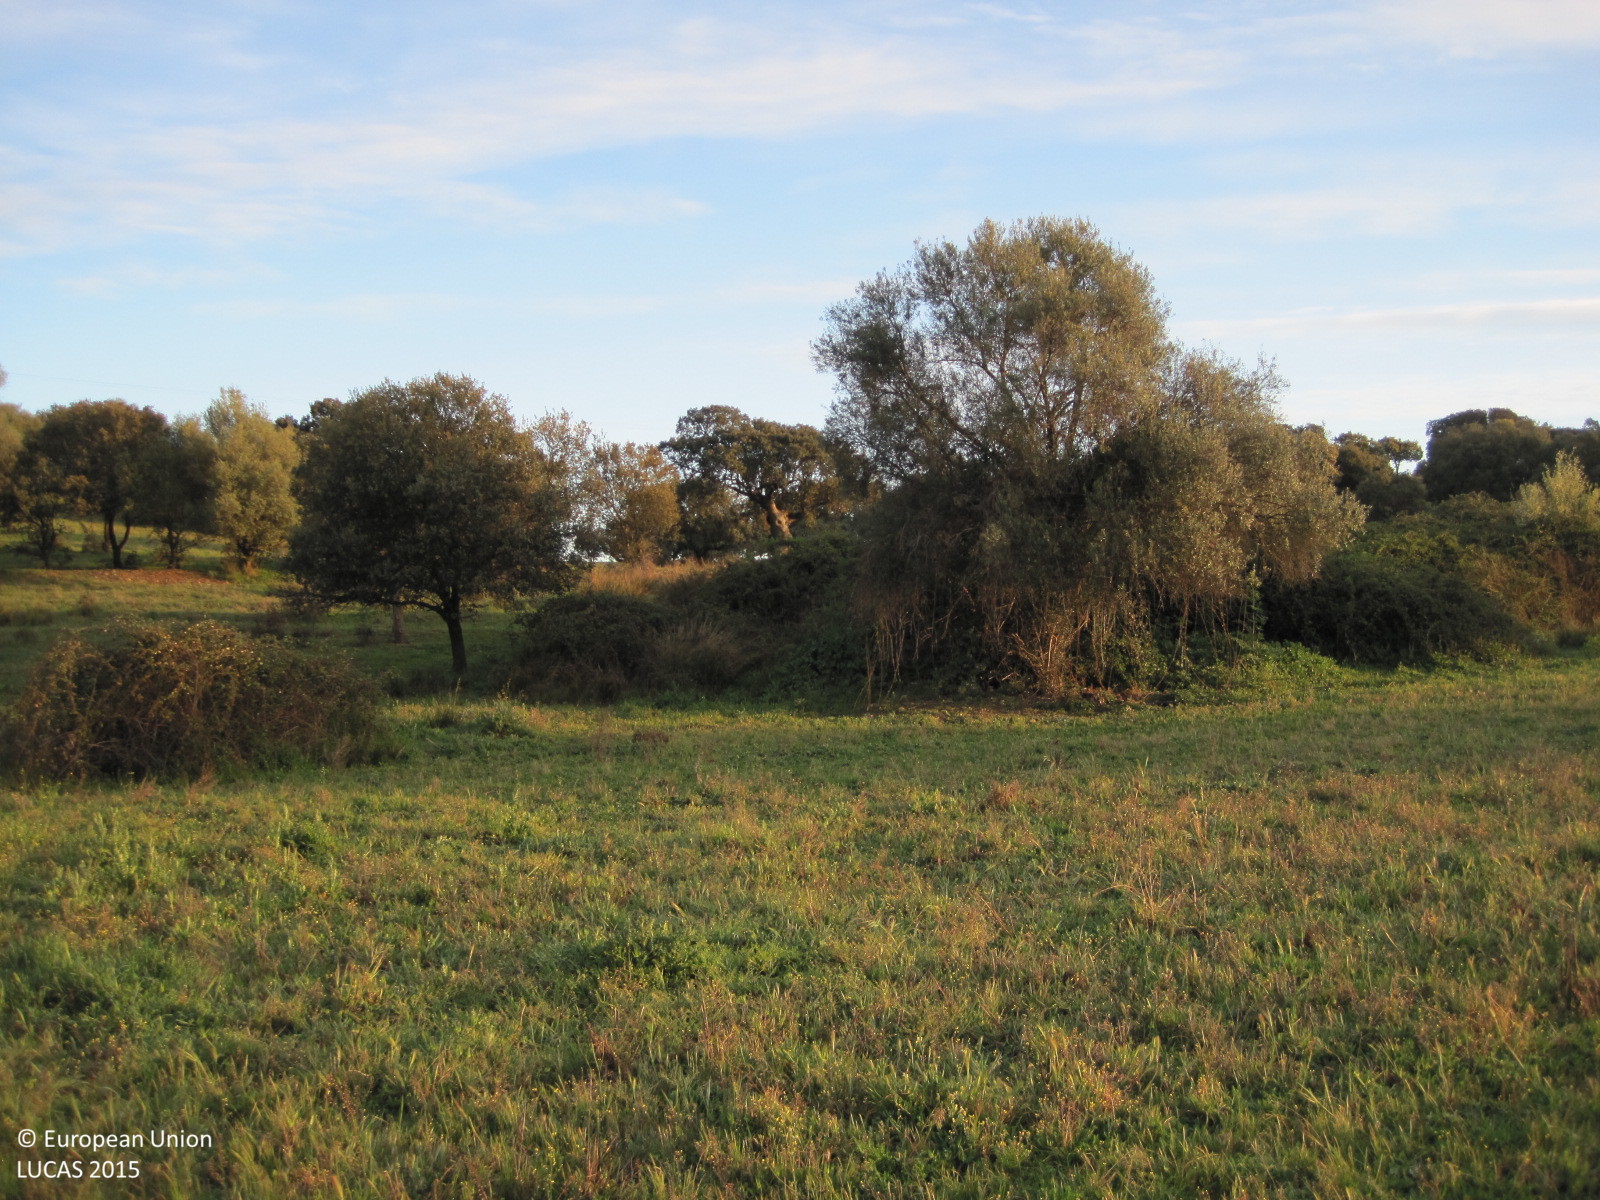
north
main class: Artificial land
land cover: Other artificial areas
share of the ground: < 10 %
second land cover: Spontaneously vegetated surfaces
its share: > 75 %
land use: Electricity, gas and thermal power distribution
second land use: Agriculture (excluding fallow land and kitchen gardens)
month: April
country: ES
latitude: 40.0085
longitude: -4.7492
